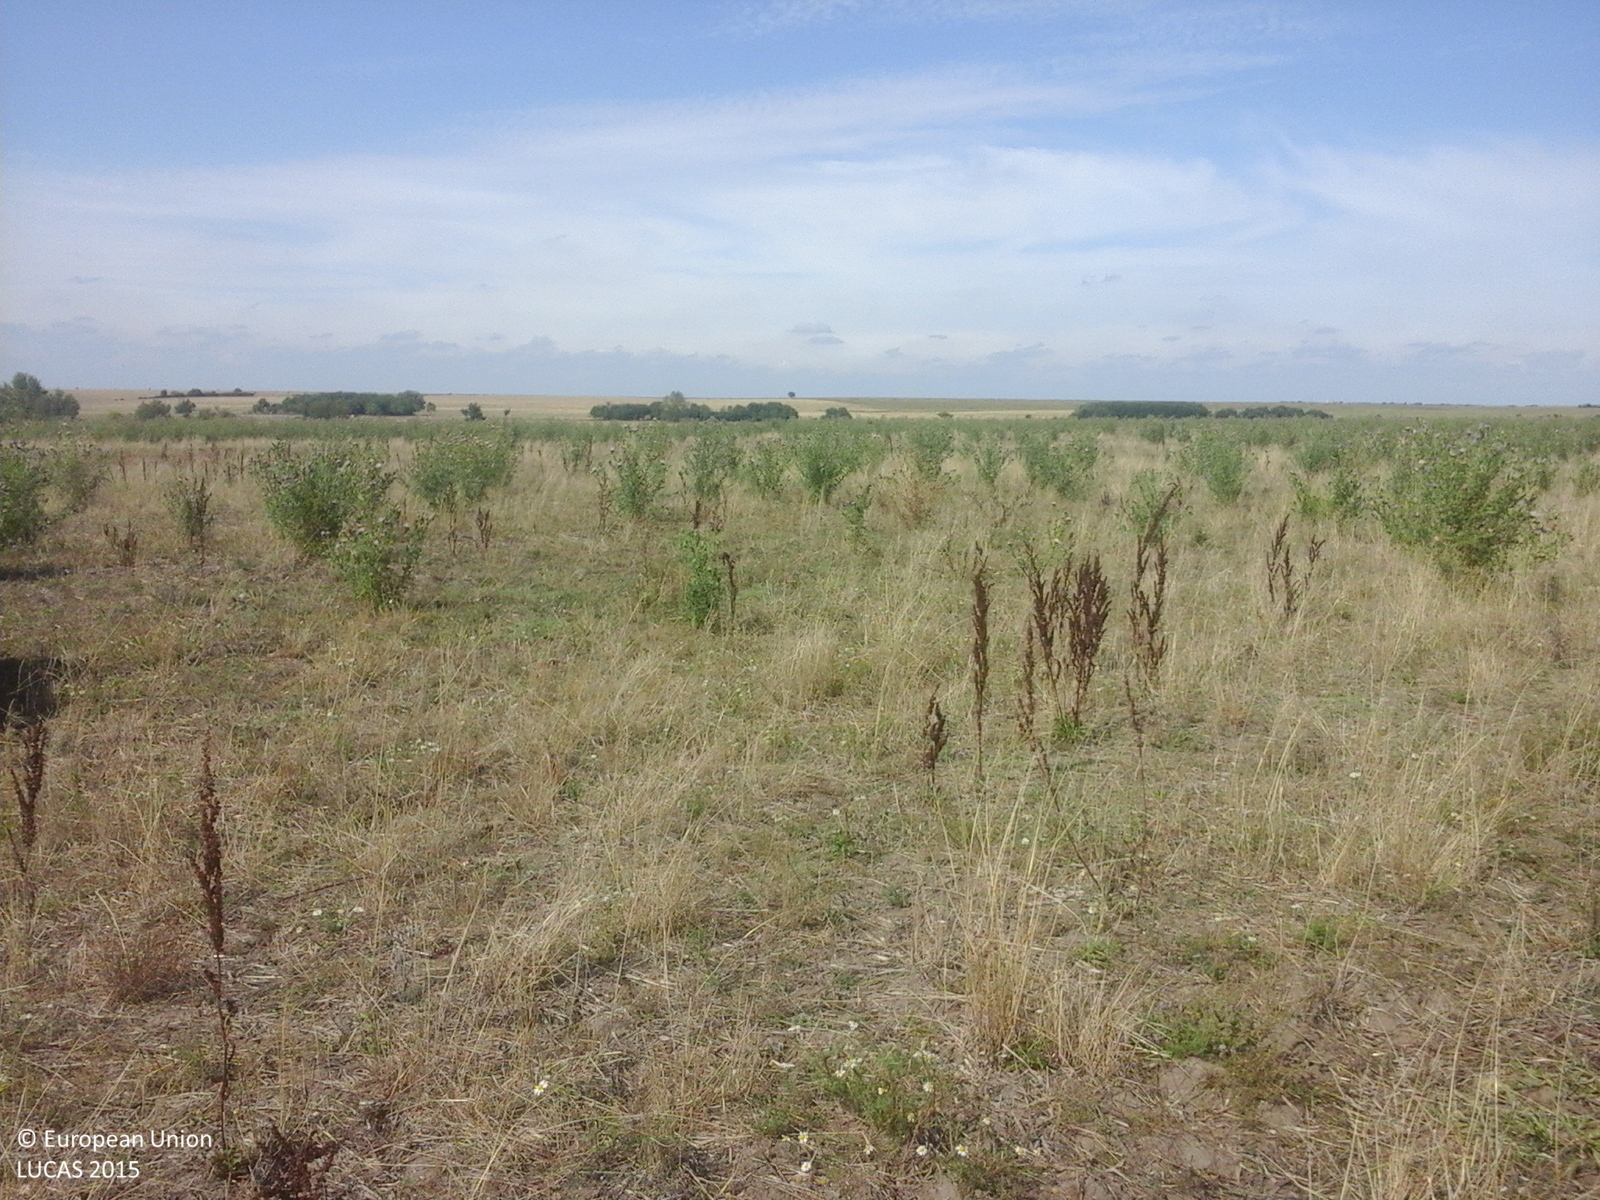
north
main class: Grassland
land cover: Spontaneously vegetated surfaces
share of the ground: > 75 %
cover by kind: herbaceous plants 100 %
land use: Fallow land
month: August
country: RO
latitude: 45.3517
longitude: 21.4548
